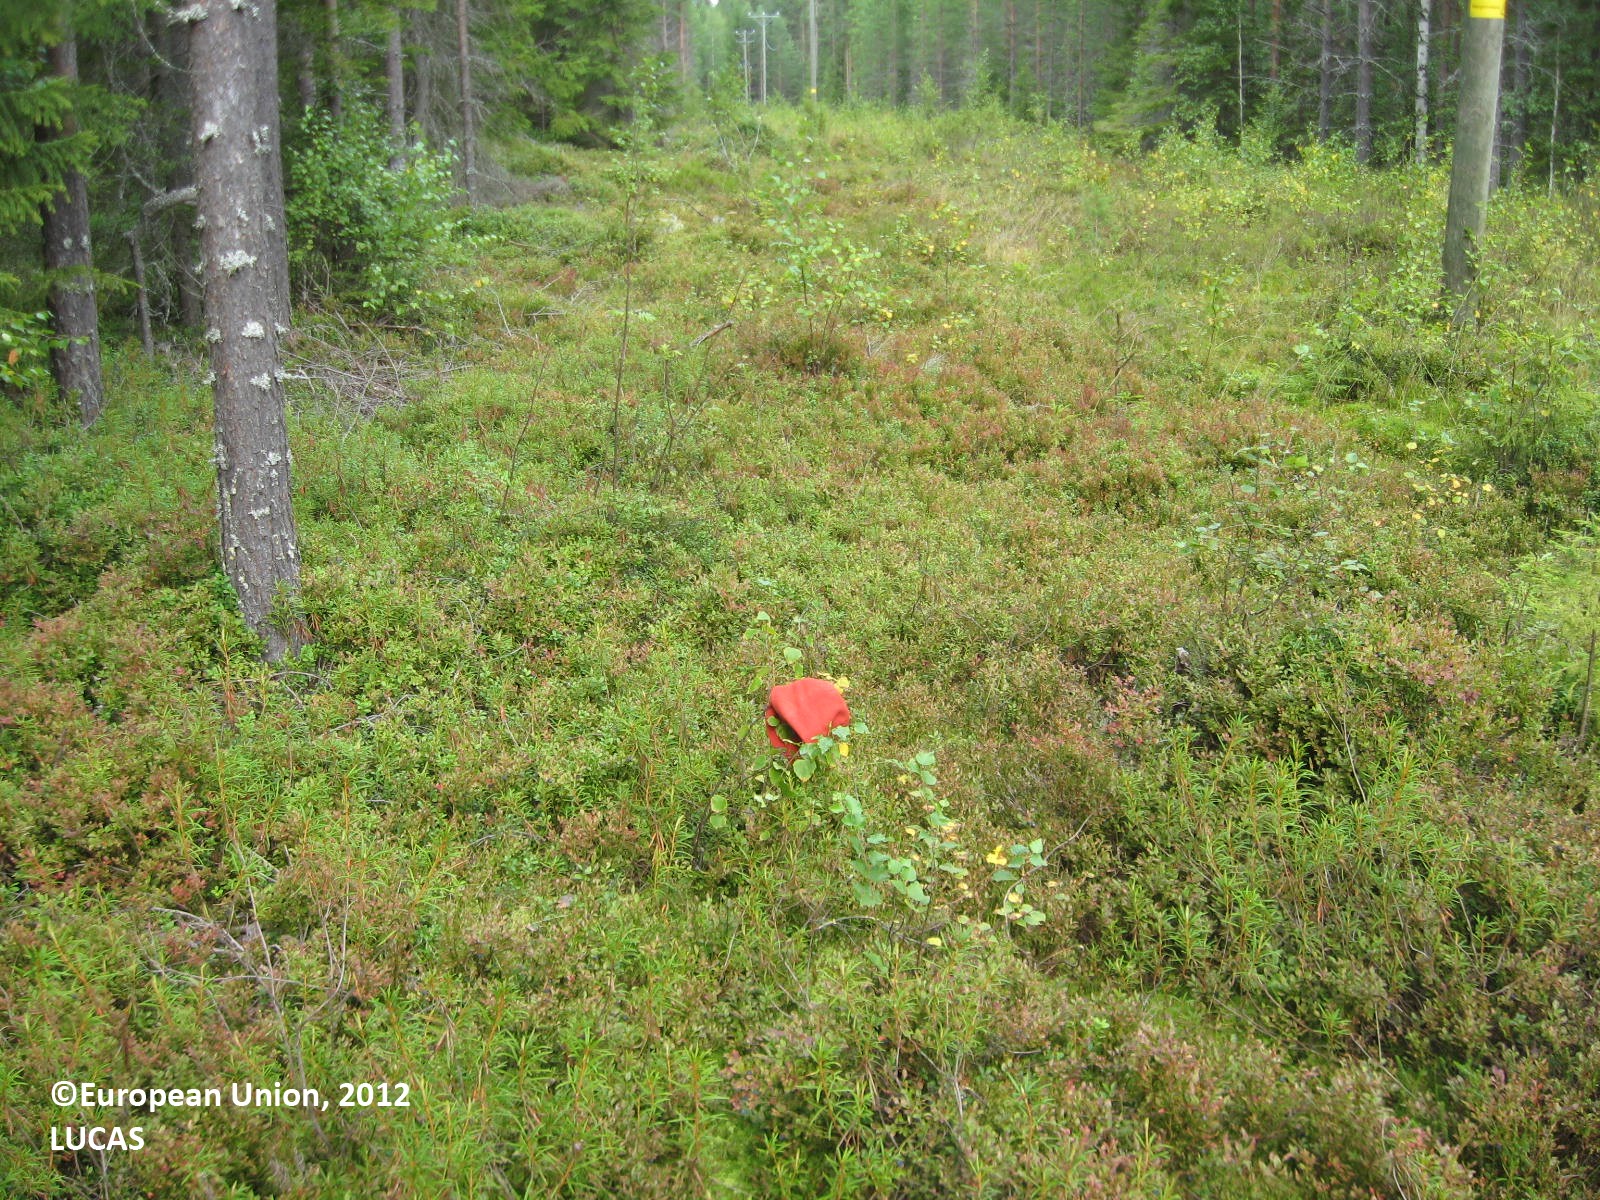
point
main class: Shrubland
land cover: Shrubland with sparse tree cover
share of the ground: > 75 %
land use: Energy production
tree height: < 5 m
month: August
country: FI
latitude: 63.4416
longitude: 29.4092
